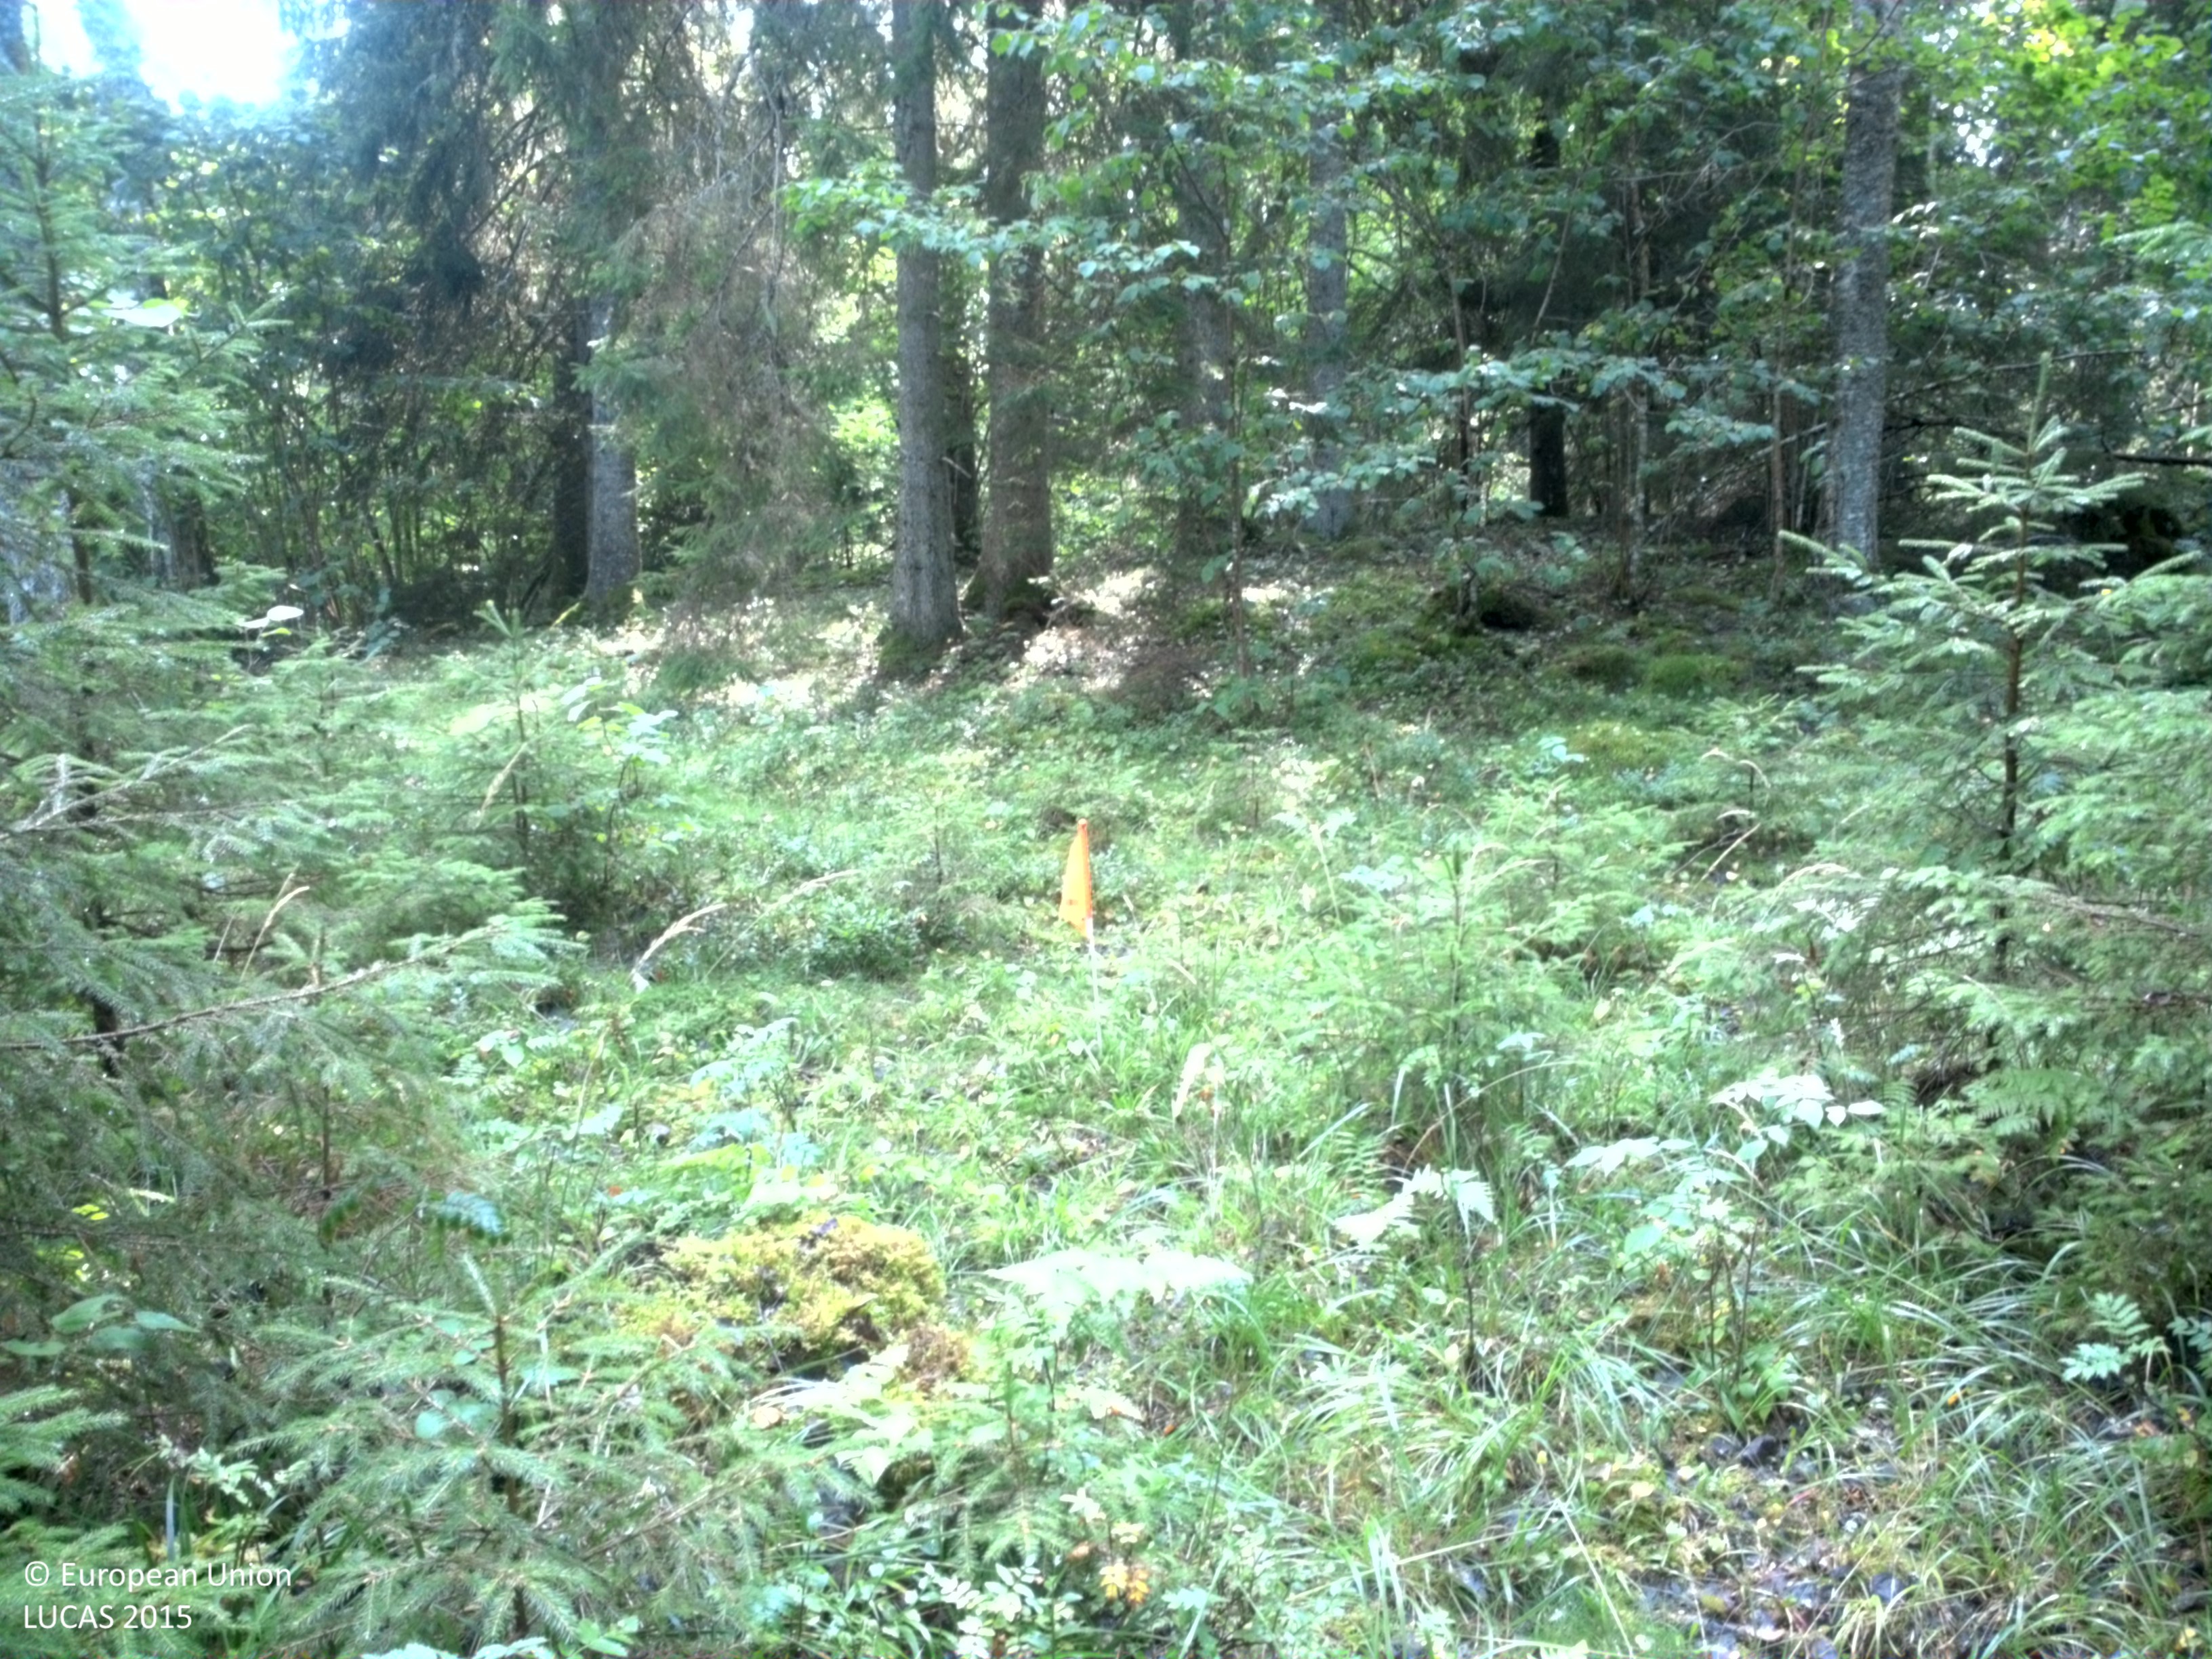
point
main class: Woodland
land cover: Spruce dominated mixed woodland
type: boreal forest
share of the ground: 25 - 50 %
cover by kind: coniferous forest trees 25 %, broadleaved forest trees 25 %, herbaceous plants 20 %, lichens and mosses 20 %, shrubs 10 %
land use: Agriculture (excluding fallow land and kitchen gardens)
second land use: Forestry
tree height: > 5 m
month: August
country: SE
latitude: 57.9450
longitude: 13.9646
